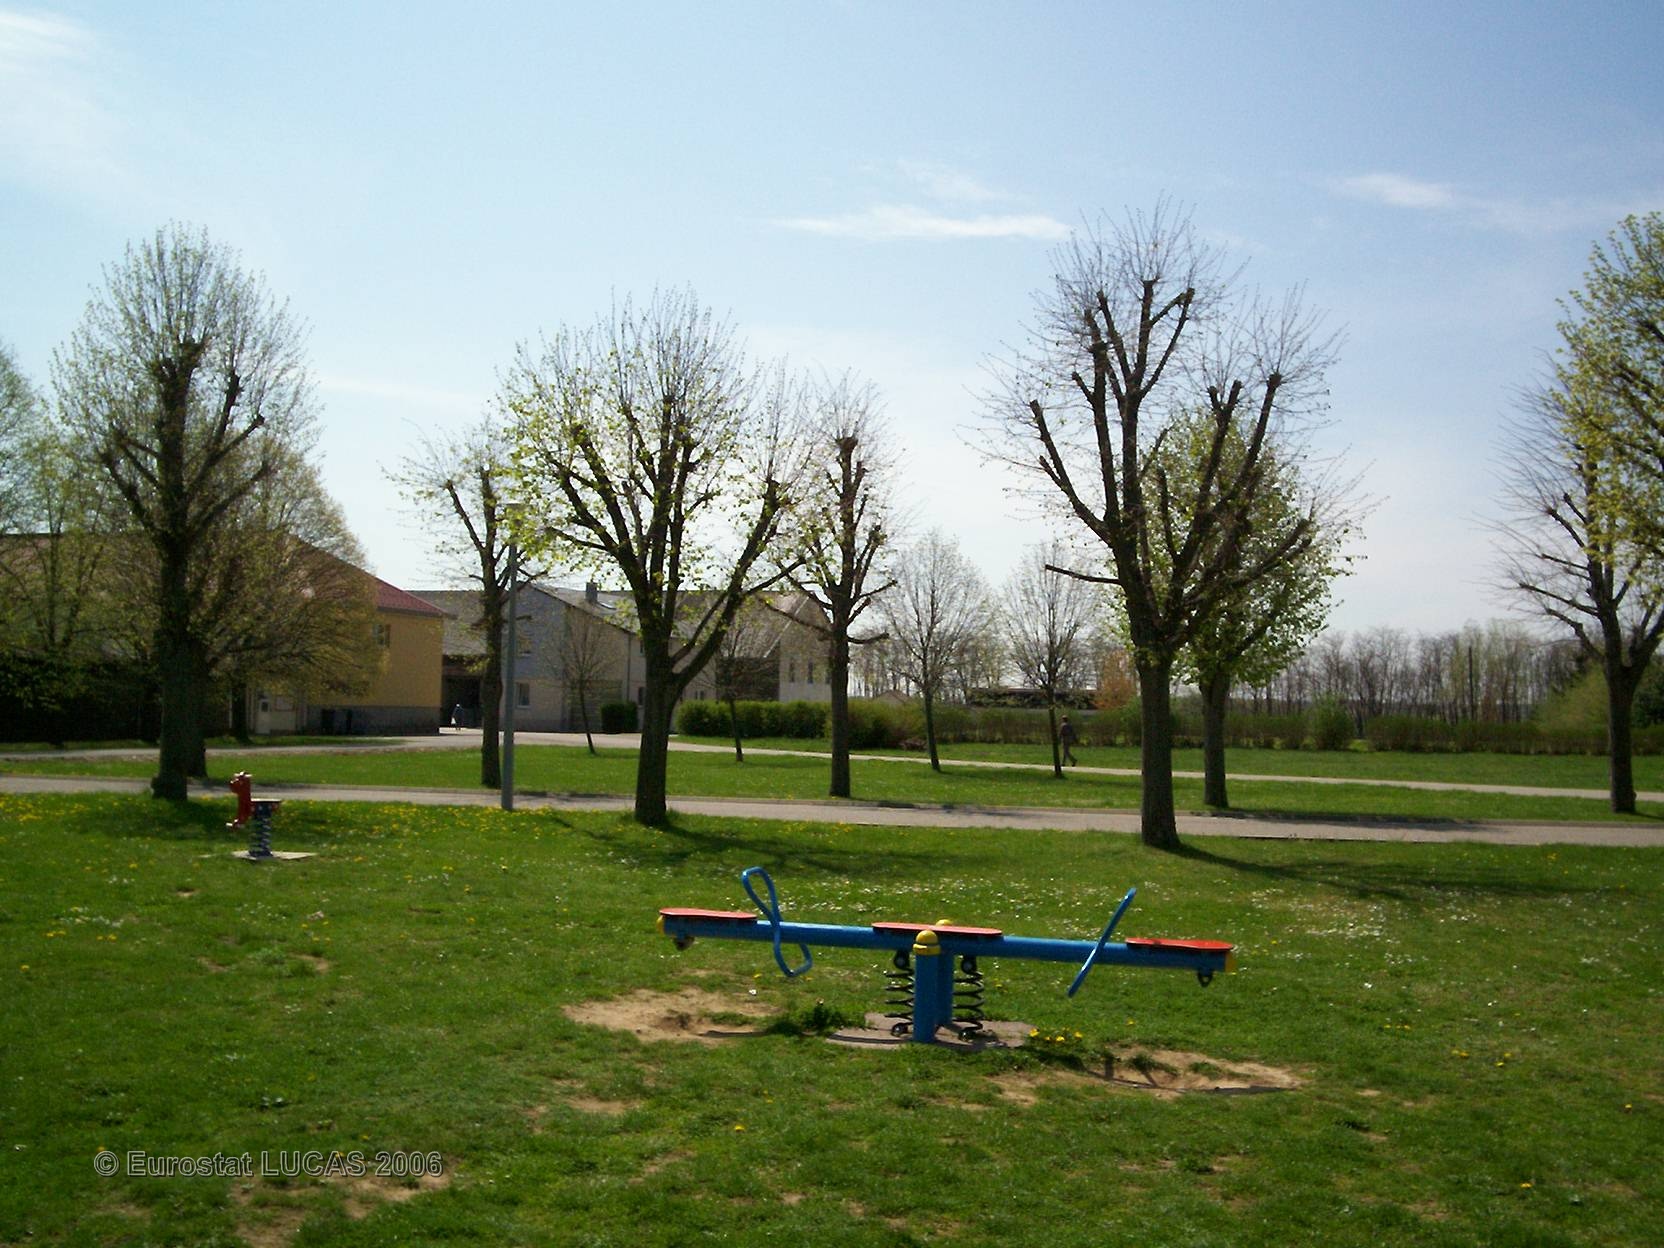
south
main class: Grassland
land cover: Grassland without tree/shrub cover
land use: Amenities, museums, leisure
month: April
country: FR
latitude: 47.7908
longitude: 7.1581
